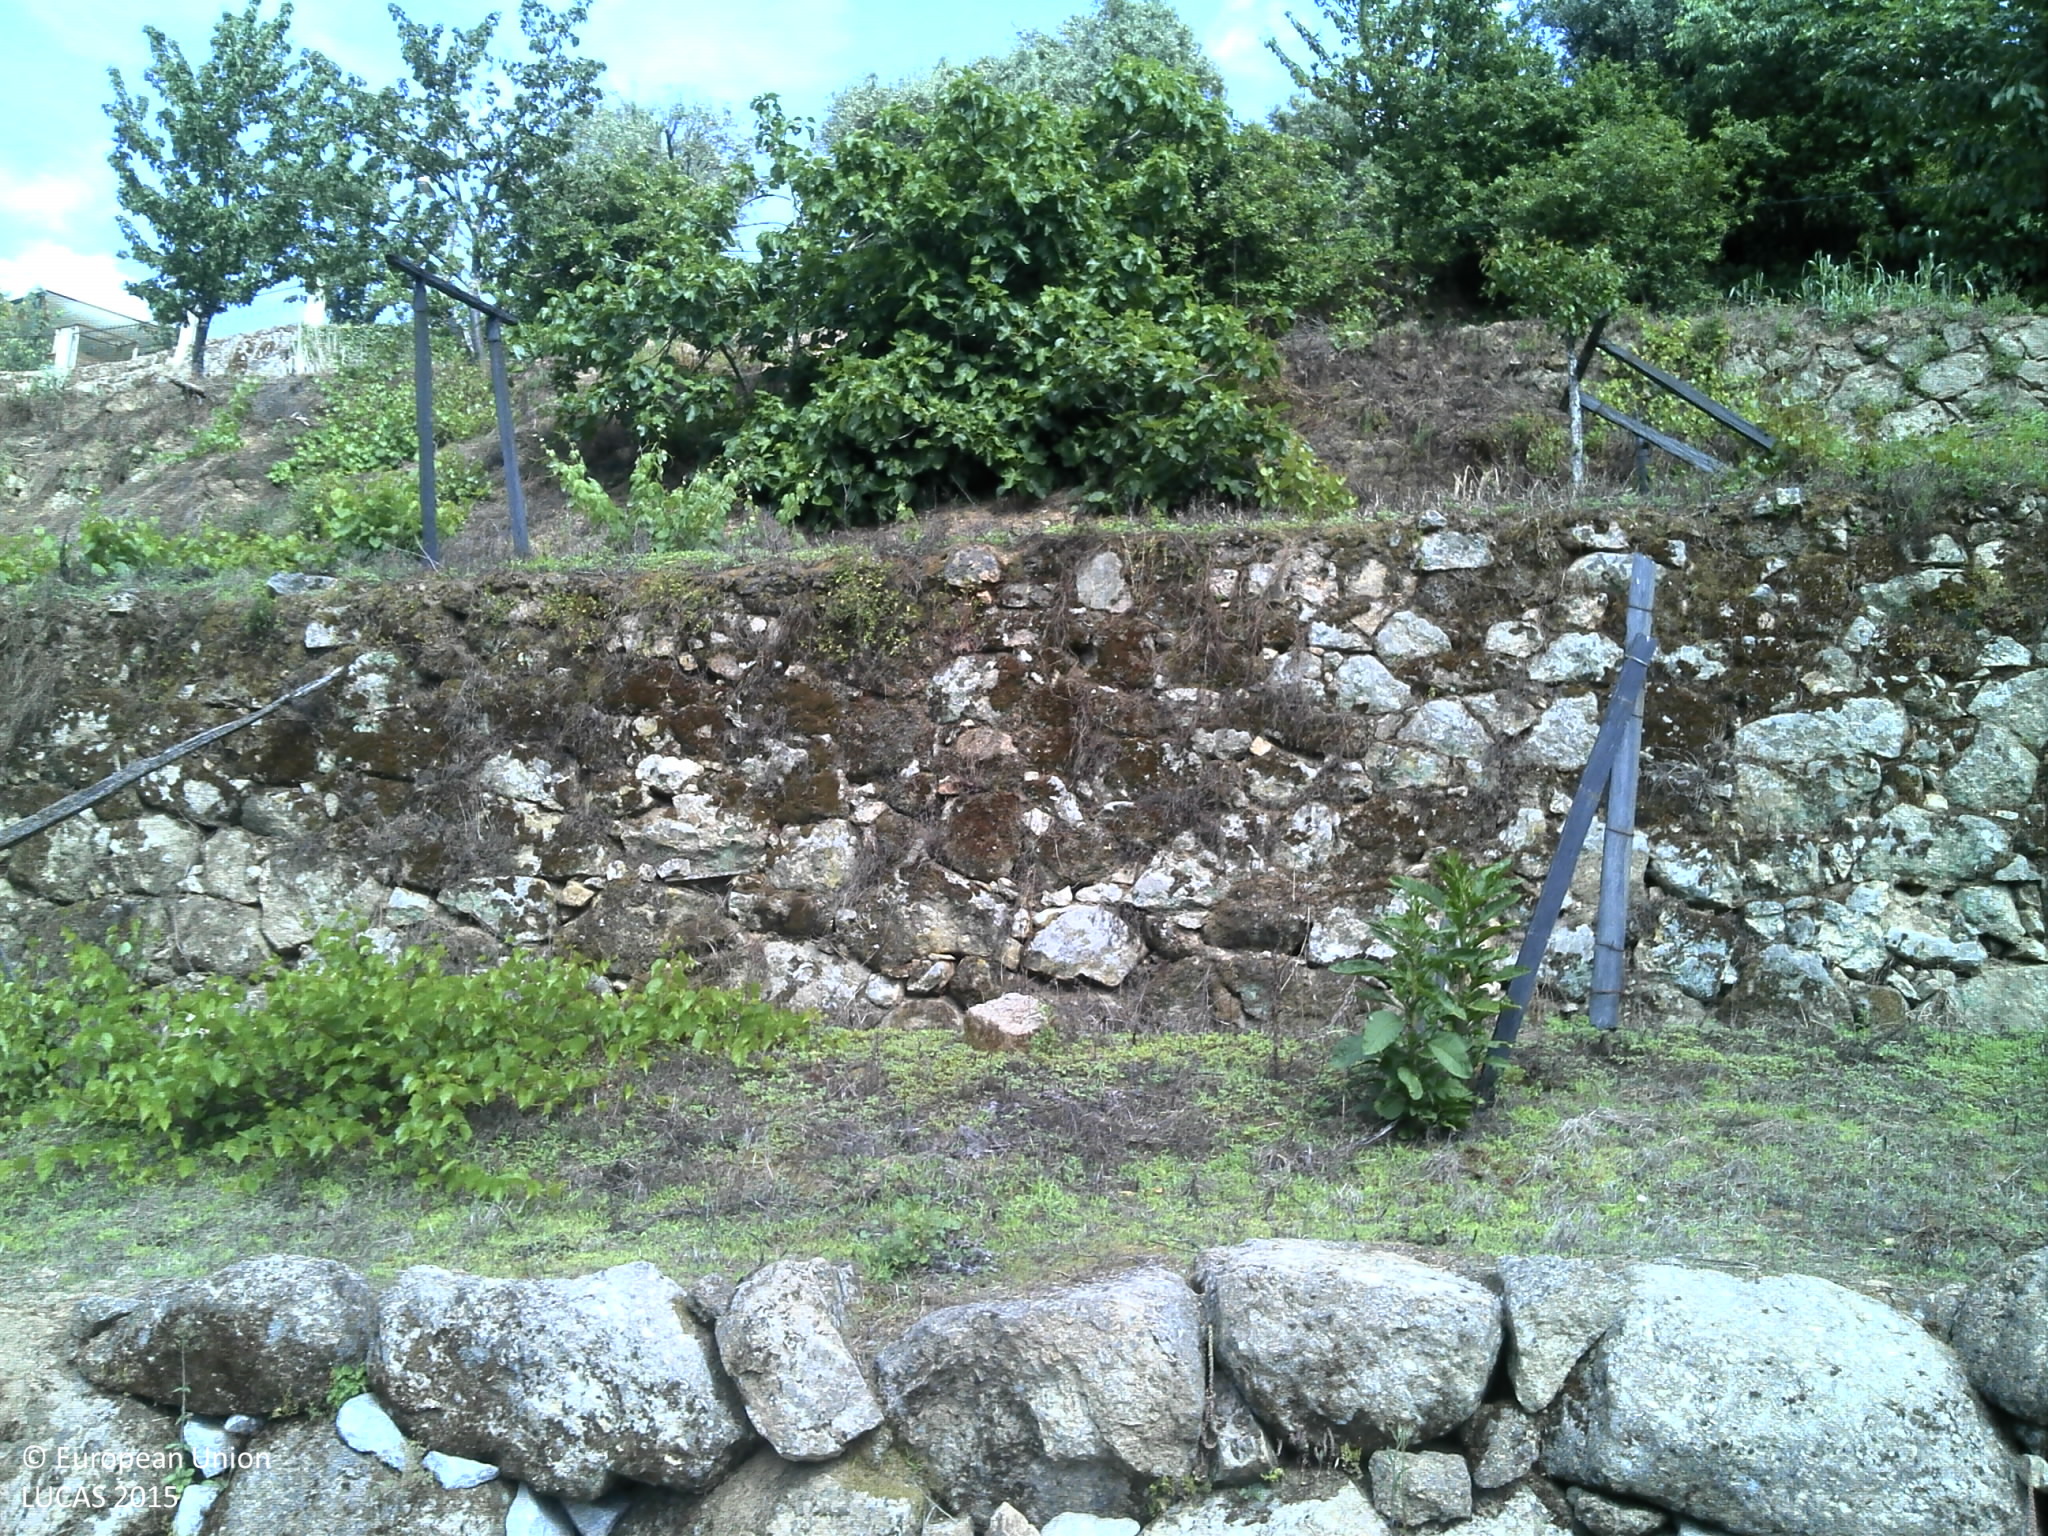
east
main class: Cropland
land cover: Cherry fruit
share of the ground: > 75 %
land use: Agriculture (excluding fallow land and kitchen gardens)
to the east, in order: Cherry fruit; Dry stone walls; Shrubland with sparse tree cover; Other bare soil; Paved roads, cycling and walking lanes; Dry stone walls; Grassland with sparse tree/shrub cover; Artificial constructions in urban areas; Cherry fruit; Electric lines; Cherry fruit; Broadleaved woodland; Cherry fruit
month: May
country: PT
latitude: 41.1155
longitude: -7.9127
